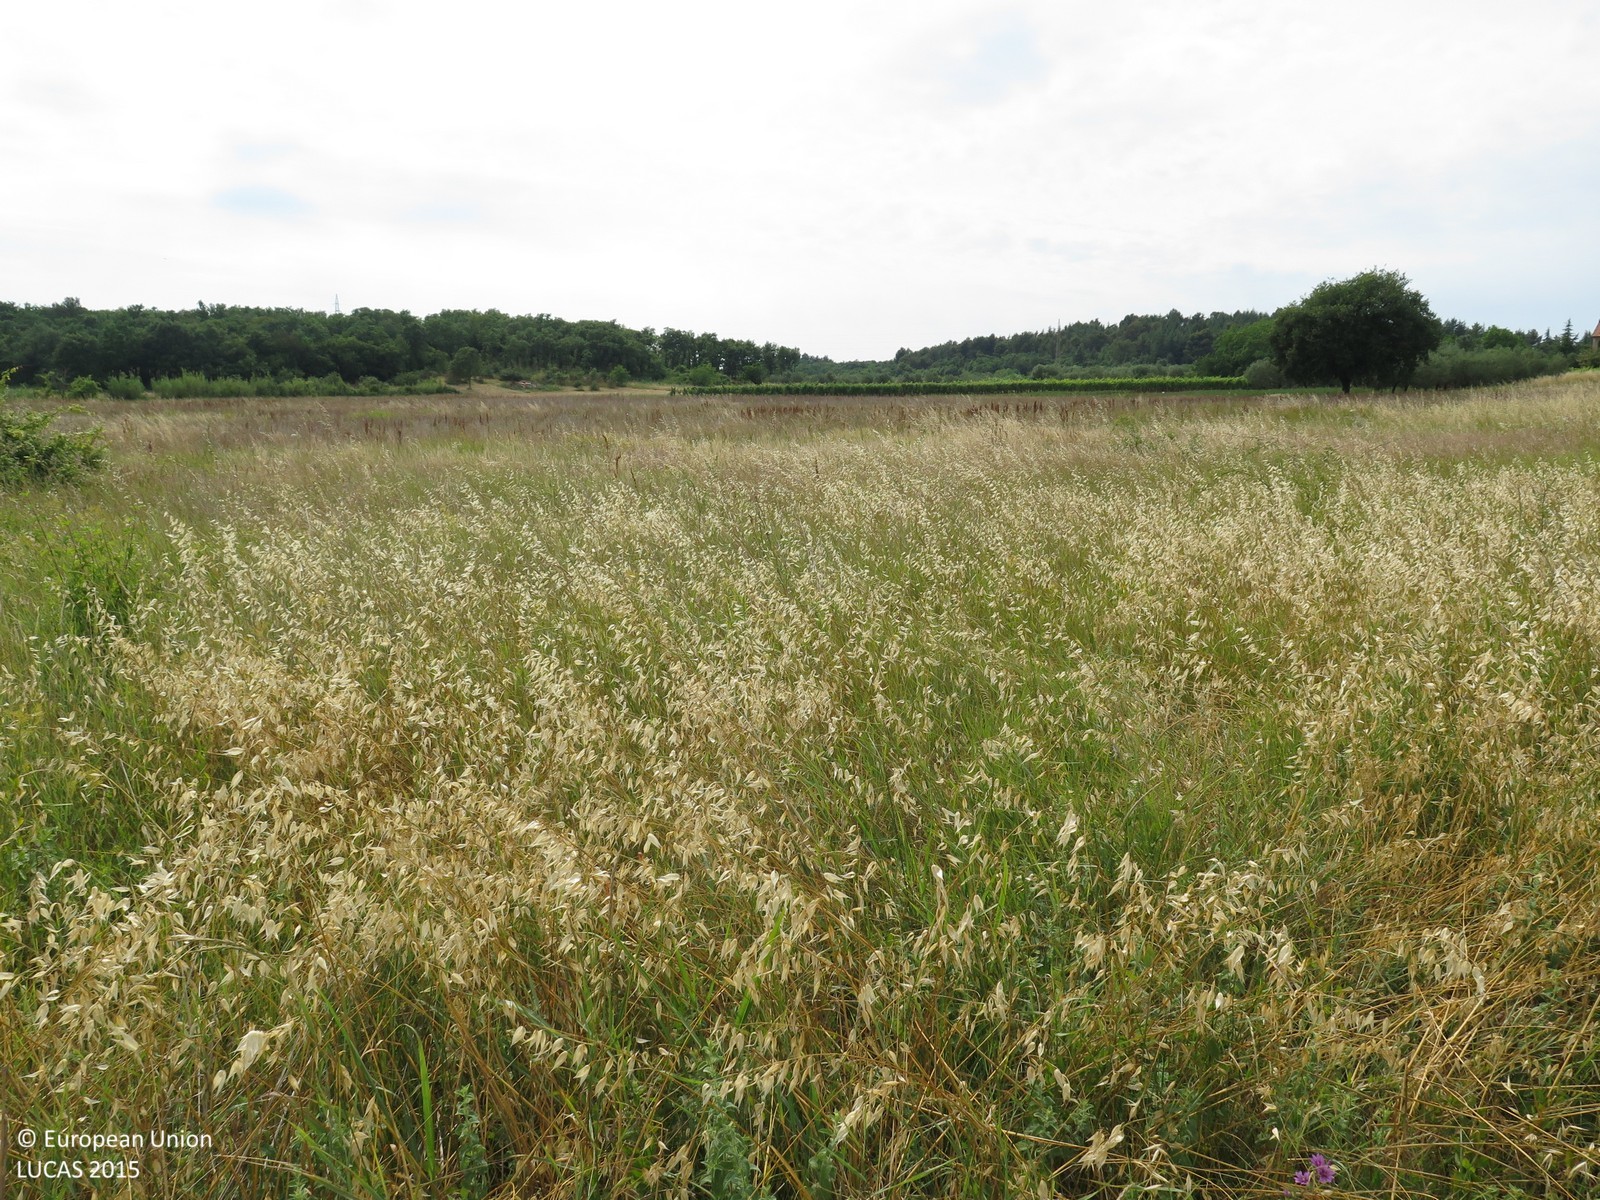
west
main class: Grassland
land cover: Grassland without tree/shrub cover
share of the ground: 25 - 50 %
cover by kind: herbaceous plants 100 %
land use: Agriculture (excluding fallow land and kitchen gardens)
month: June
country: HR
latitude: 45.1897
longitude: 13.6223
